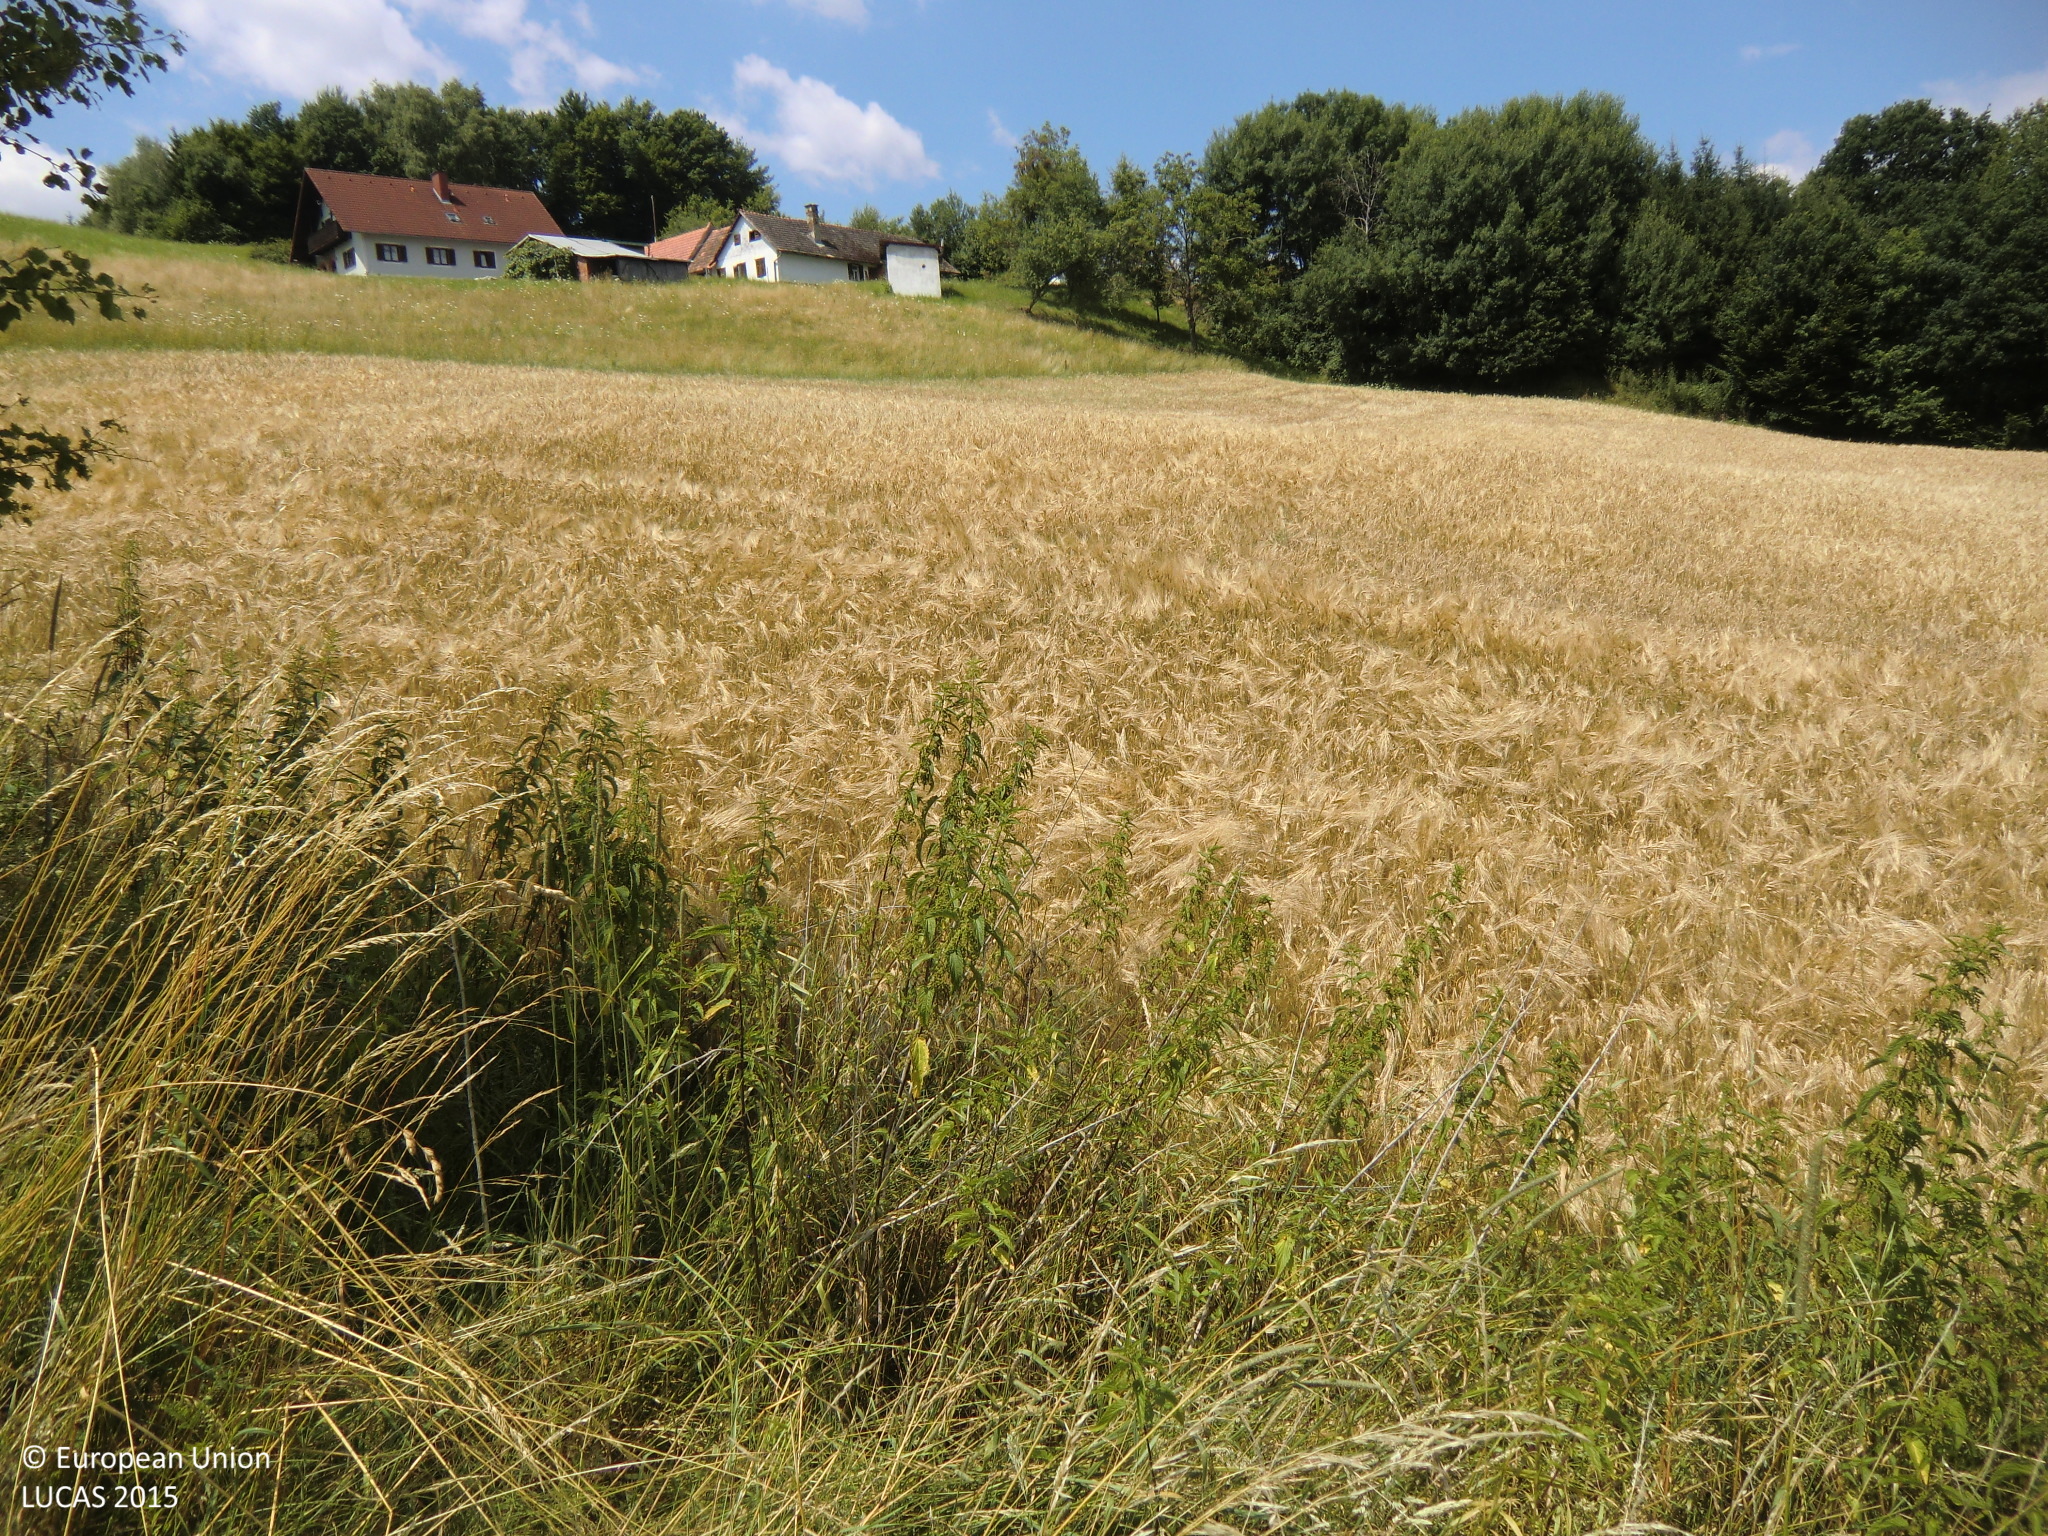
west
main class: Cropland
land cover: Barley
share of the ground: > 75 %
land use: Agriculture (excluding fallow land and kitchen gardens)
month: July
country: AT
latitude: 46.9724
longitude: 16.0870
